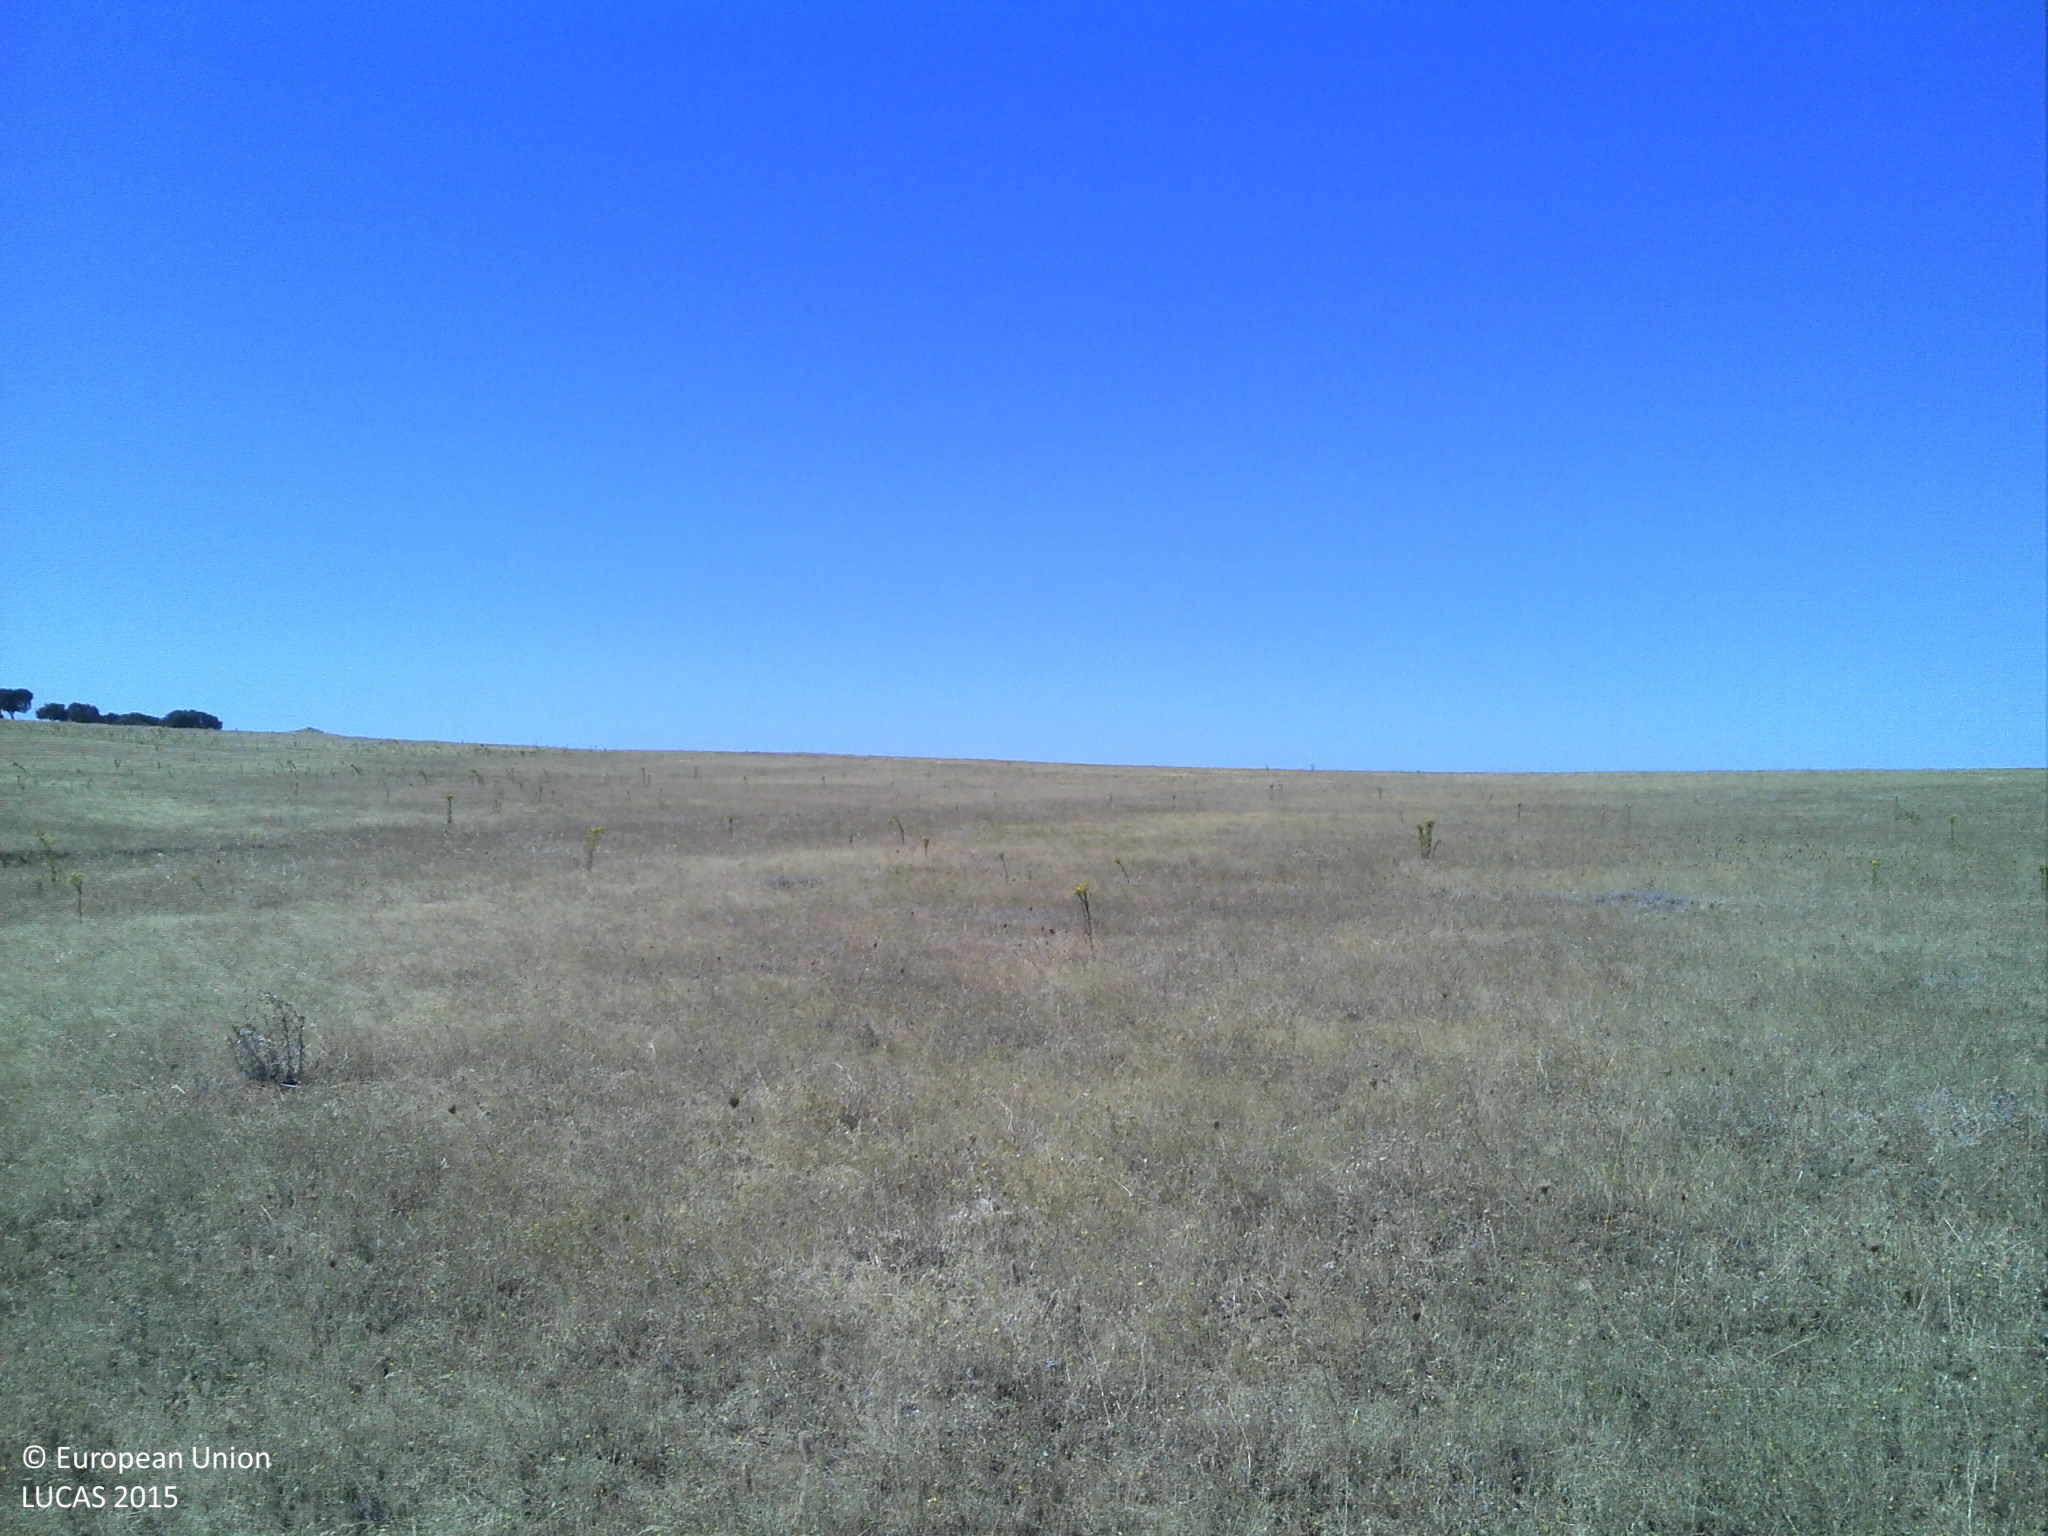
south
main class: Grassland
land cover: Spontaneously vegetated surfaces
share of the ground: 10 - 25 %
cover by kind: unconsolidated bare surface 85 %, herbaceous plants 15 %
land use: Fallow land
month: July
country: PT
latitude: 39.0534
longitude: -7.0732
